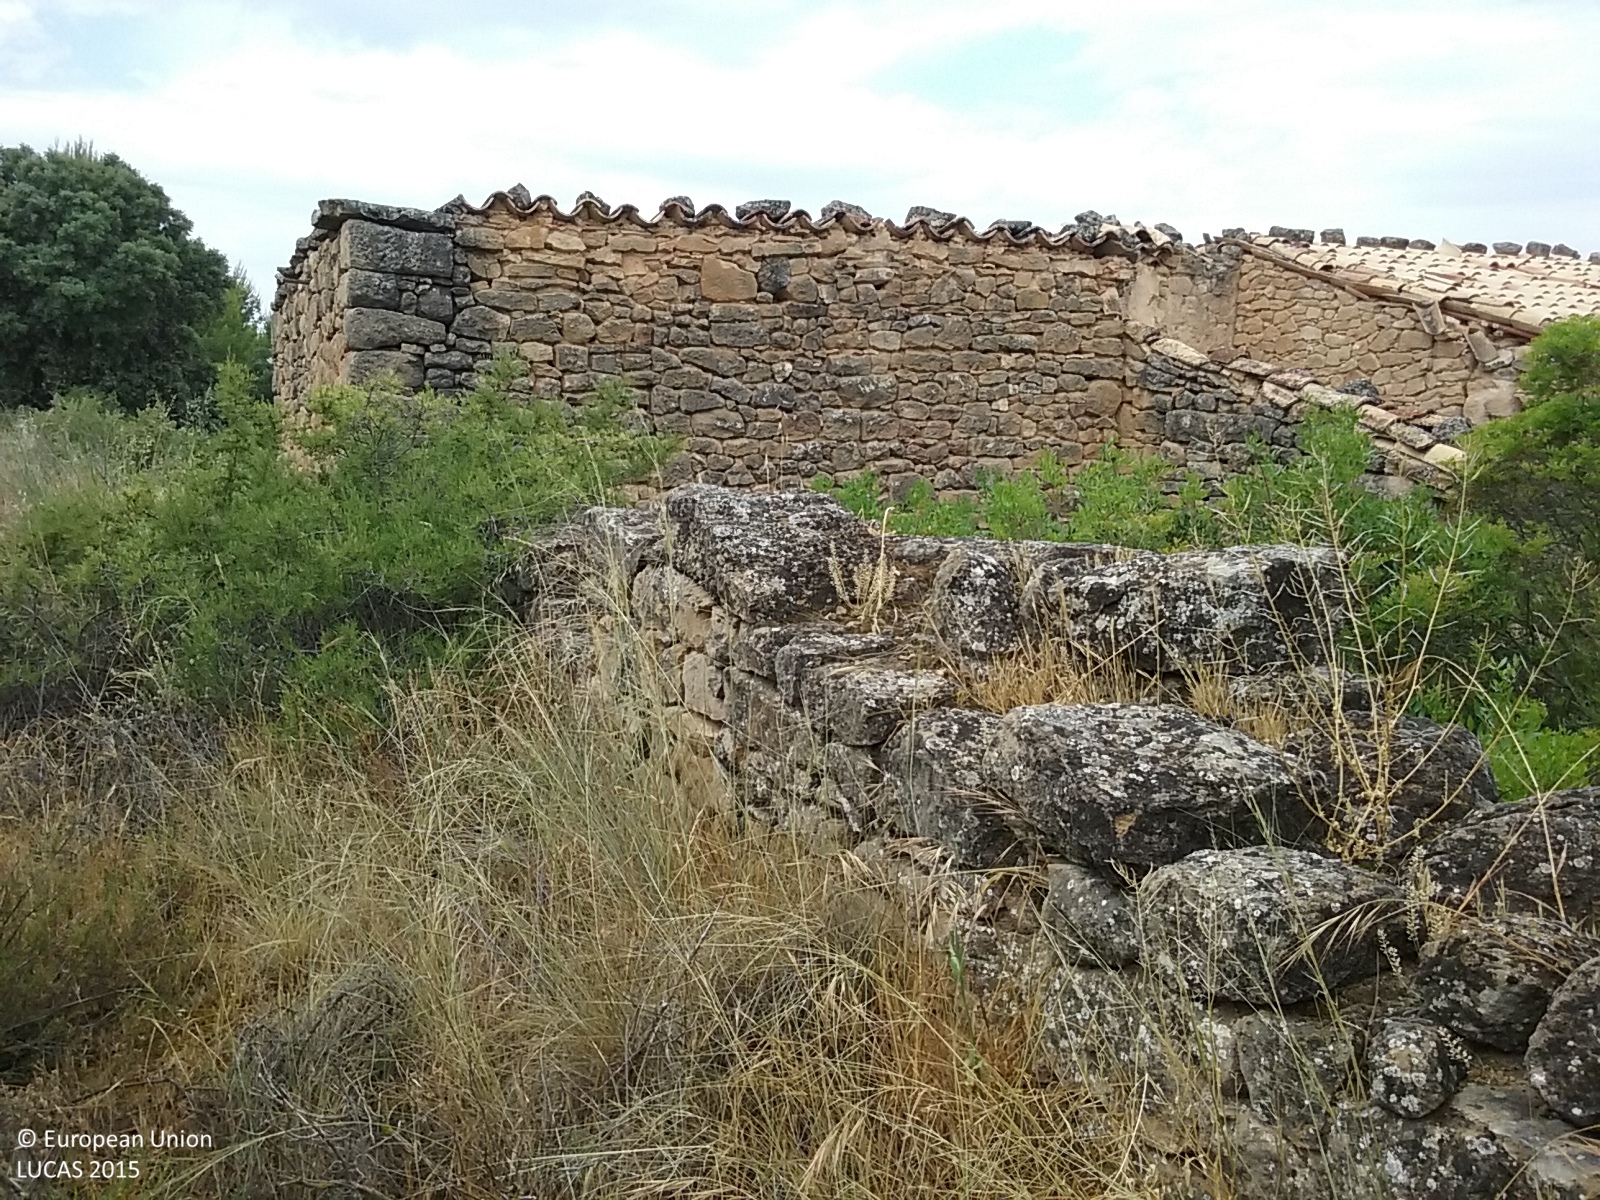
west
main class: Woodland
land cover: Broadleaved woodland
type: broadleaved evergreen forest
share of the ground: > 75 %
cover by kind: broadleaved forest trees 90 %, shrubs 10 %
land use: Semi-natural and natural areas not in use
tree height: > 5 m
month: June
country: ES
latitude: 40.9556
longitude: 0.1658
